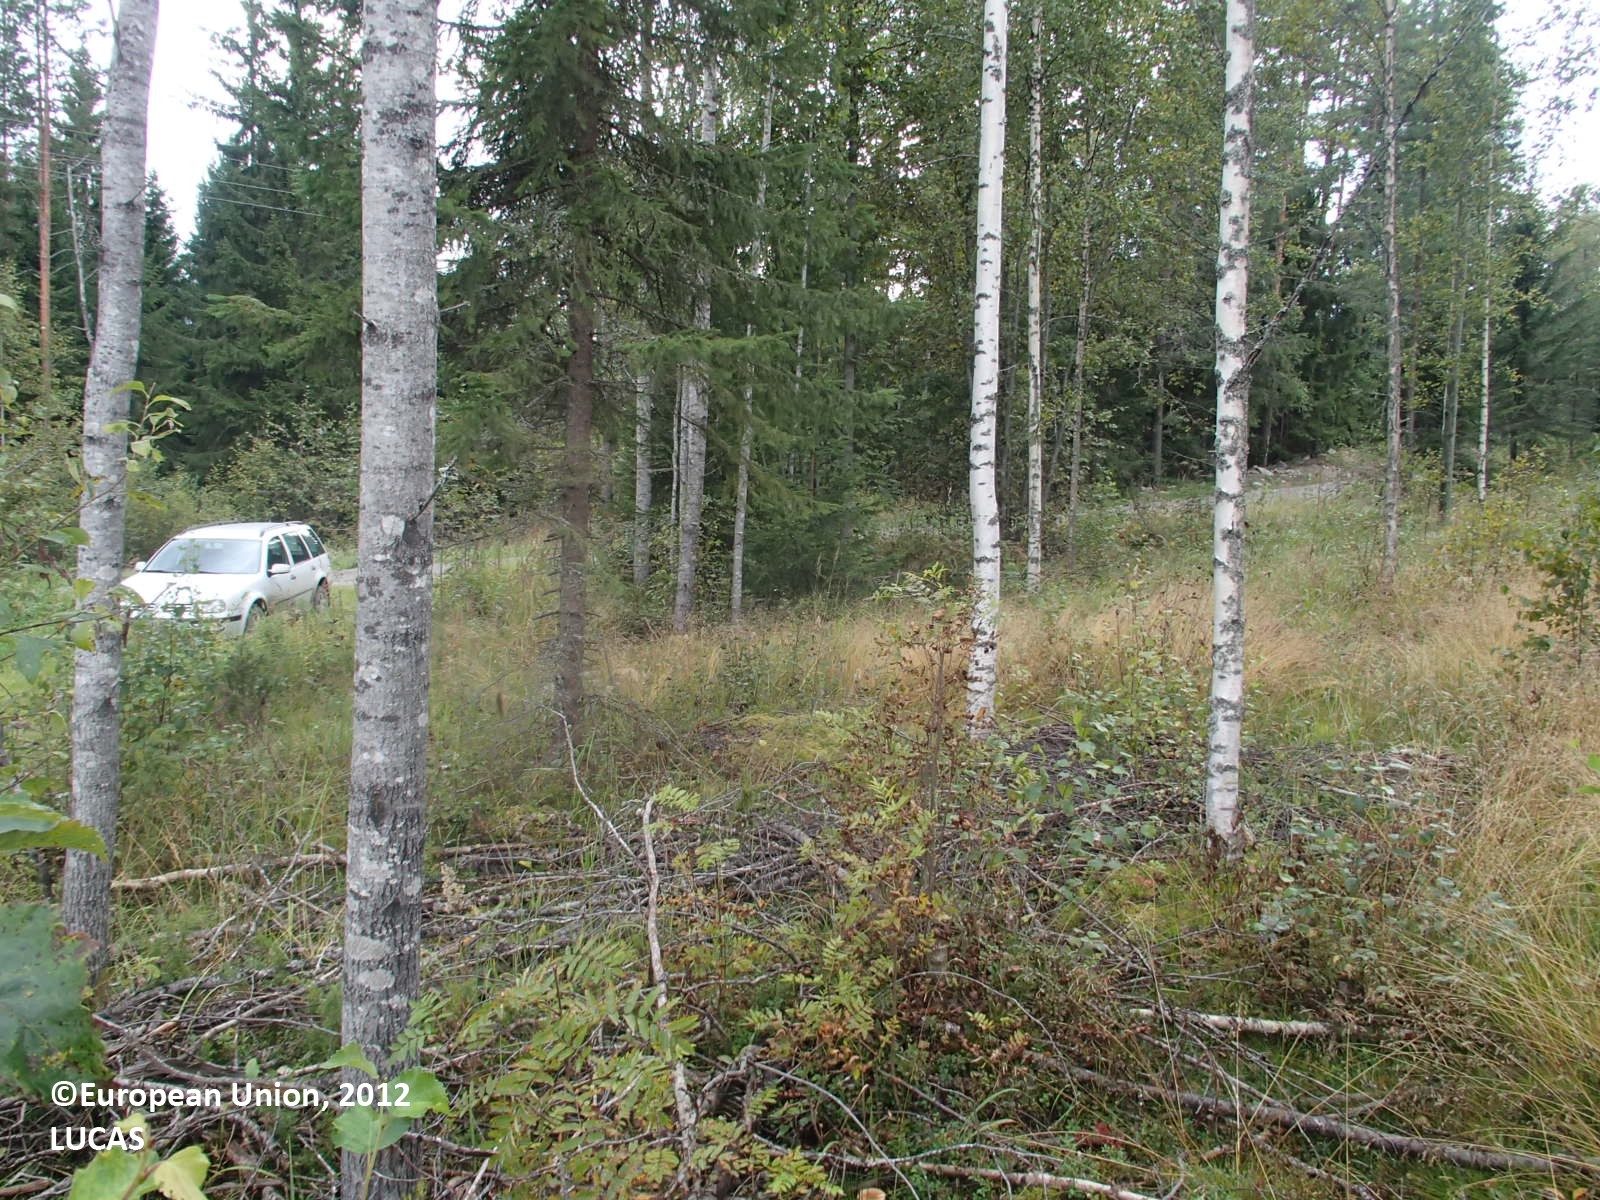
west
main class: Woodland
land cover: Spruce dominated mixed woodland
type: boreal forest
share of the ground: > 75 %
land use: Forestry
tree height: > 5 m
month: August
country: FI
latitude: 63.4769
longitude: 27.1046
